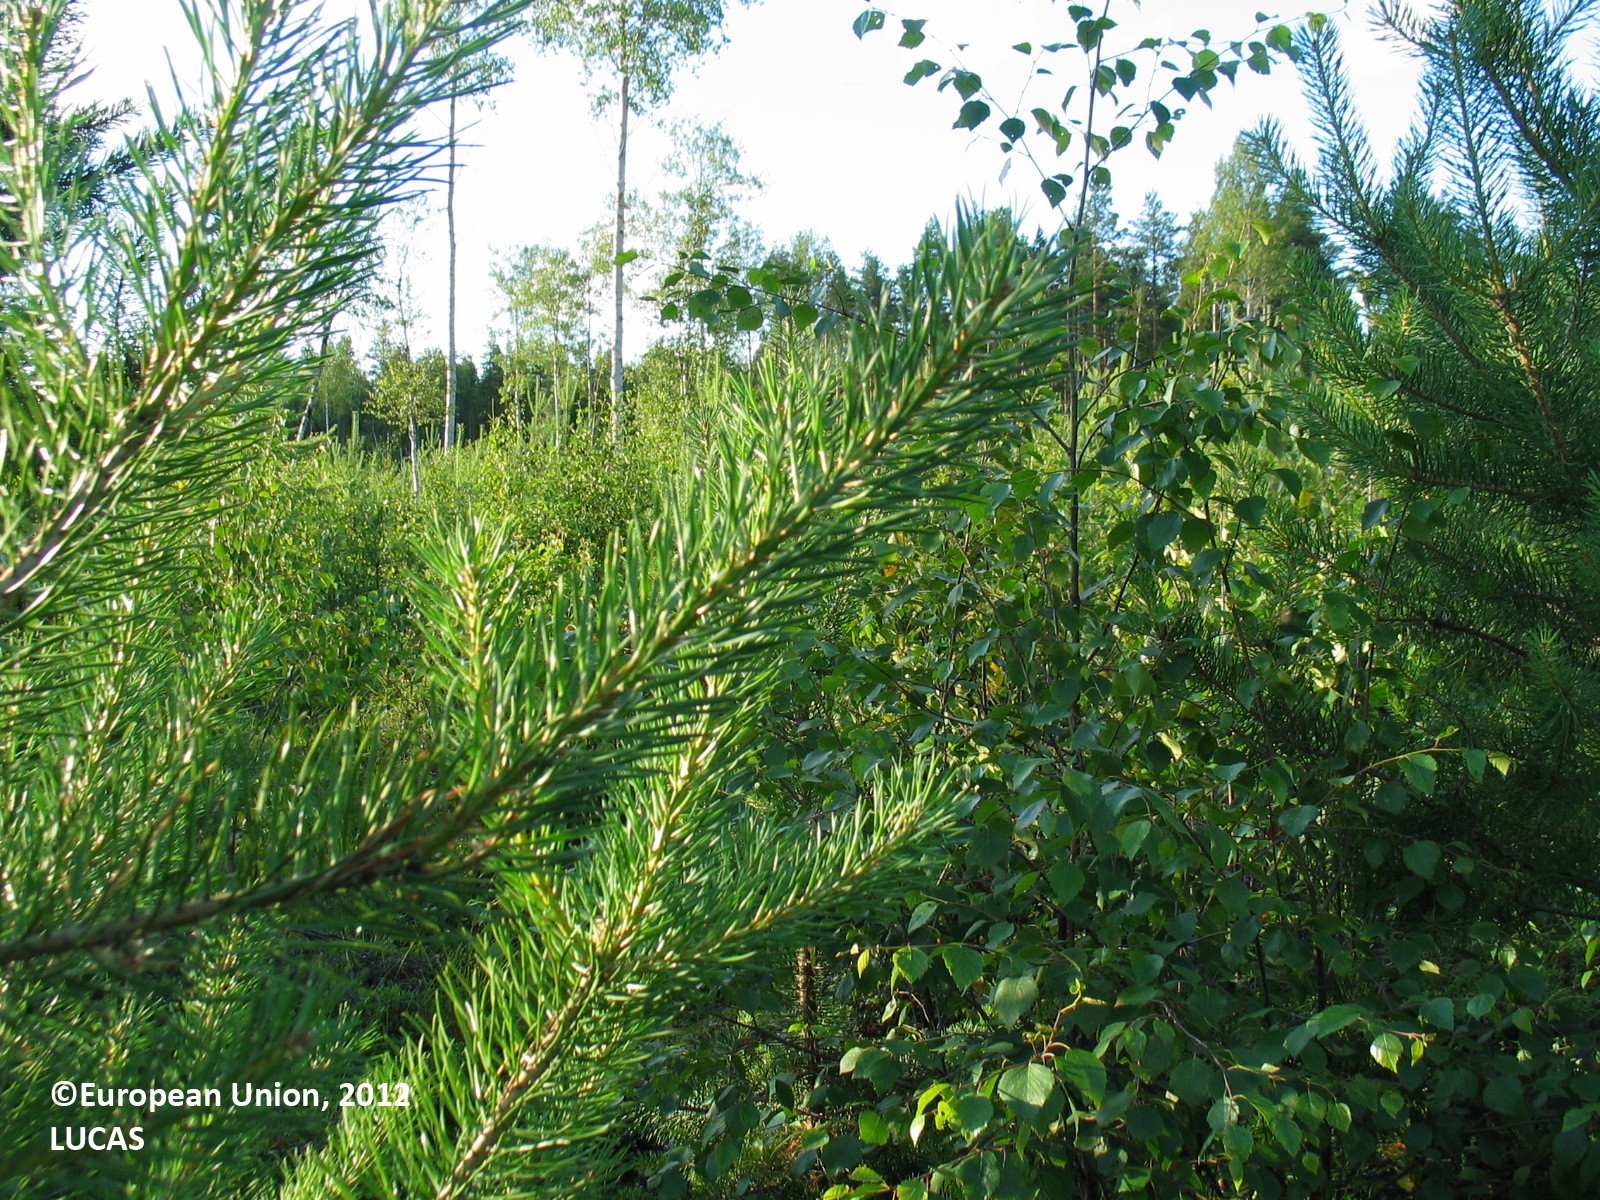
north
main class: Woodland
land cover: Pine dominated mixed woodland
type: boreal forest
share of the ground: 50 - 75 %
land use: Forestry
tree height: < 5 m
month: July
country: FI
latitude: 64.6384
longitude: 26.4964
